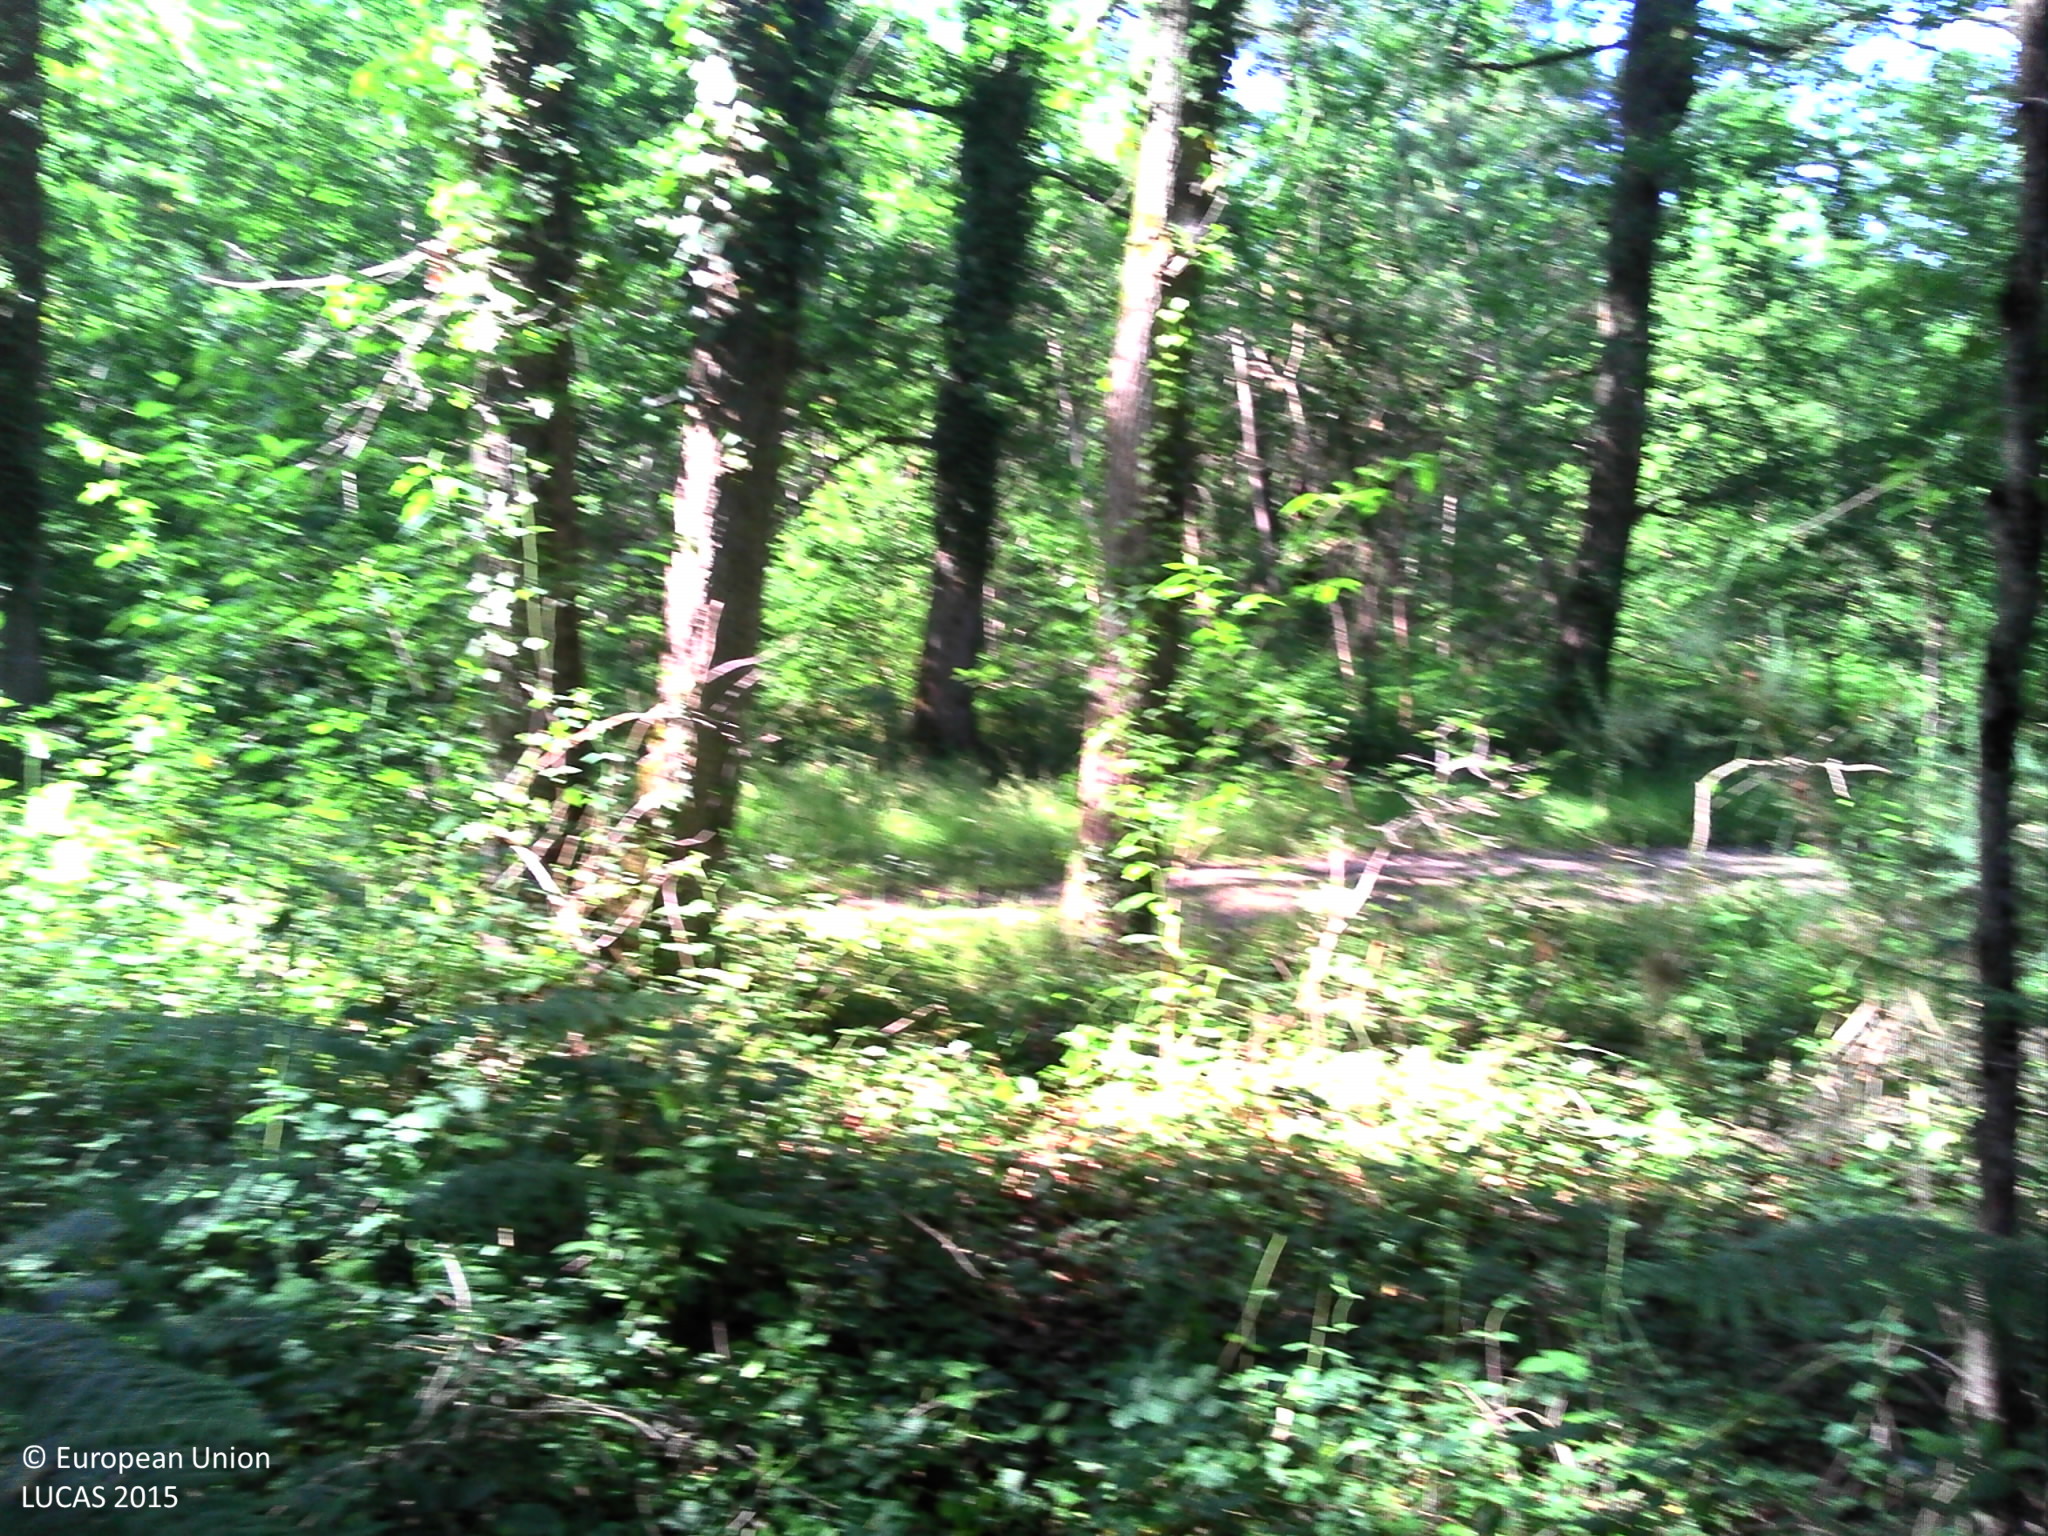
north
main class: Woodland
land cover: Broadleaved woodland
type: acidophilous oak and oak-birch forest
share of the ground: > 75 %
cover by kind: broadleaved forest trees 85 %, herbaceous plants 10 %, shrubs 5 %
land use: Forestry
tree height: > 5 m
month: June
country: FR
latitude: 46.9308
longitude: 0.1666
